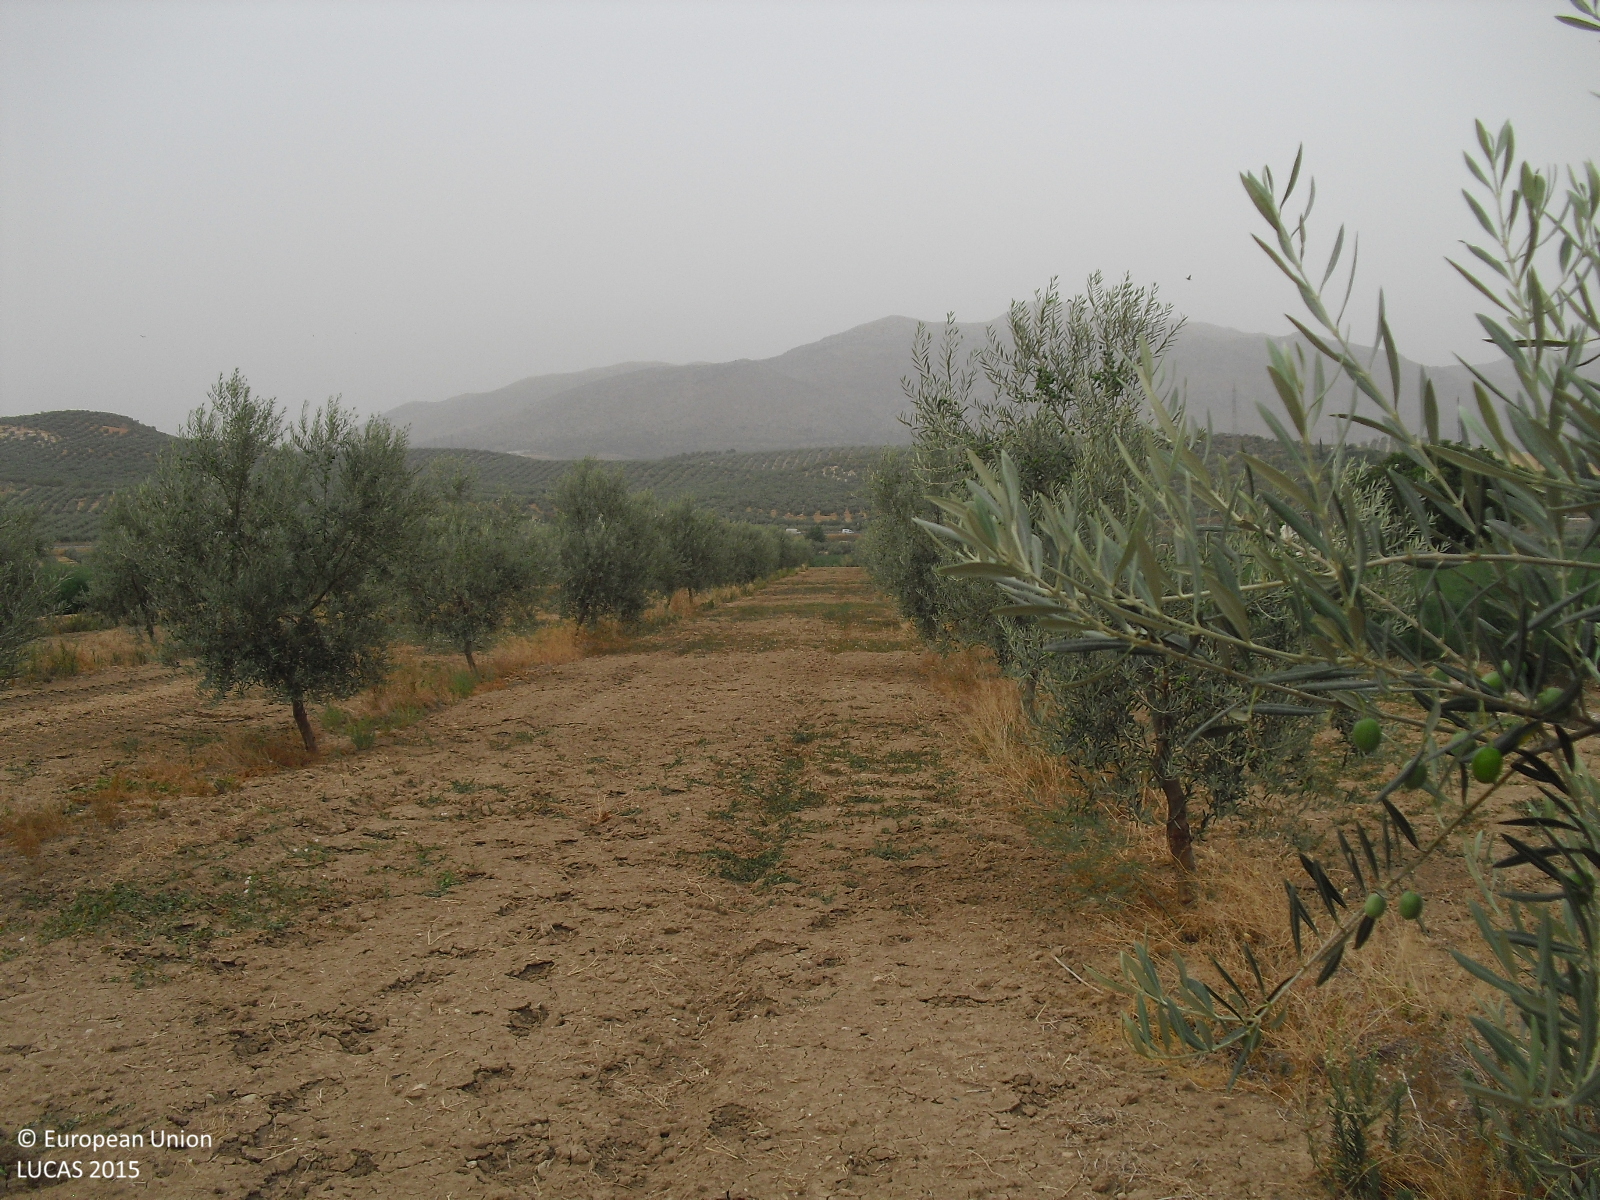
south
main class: Cropland
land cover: Olive groves
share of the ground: < 10 %
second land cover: Spontaneously vegetated surfaces
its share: 10 - 25 %
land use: Agriculture (excluding fallow land and kitchen gardens)
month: August
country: ES
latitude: 37.1683
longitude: -4.1053
